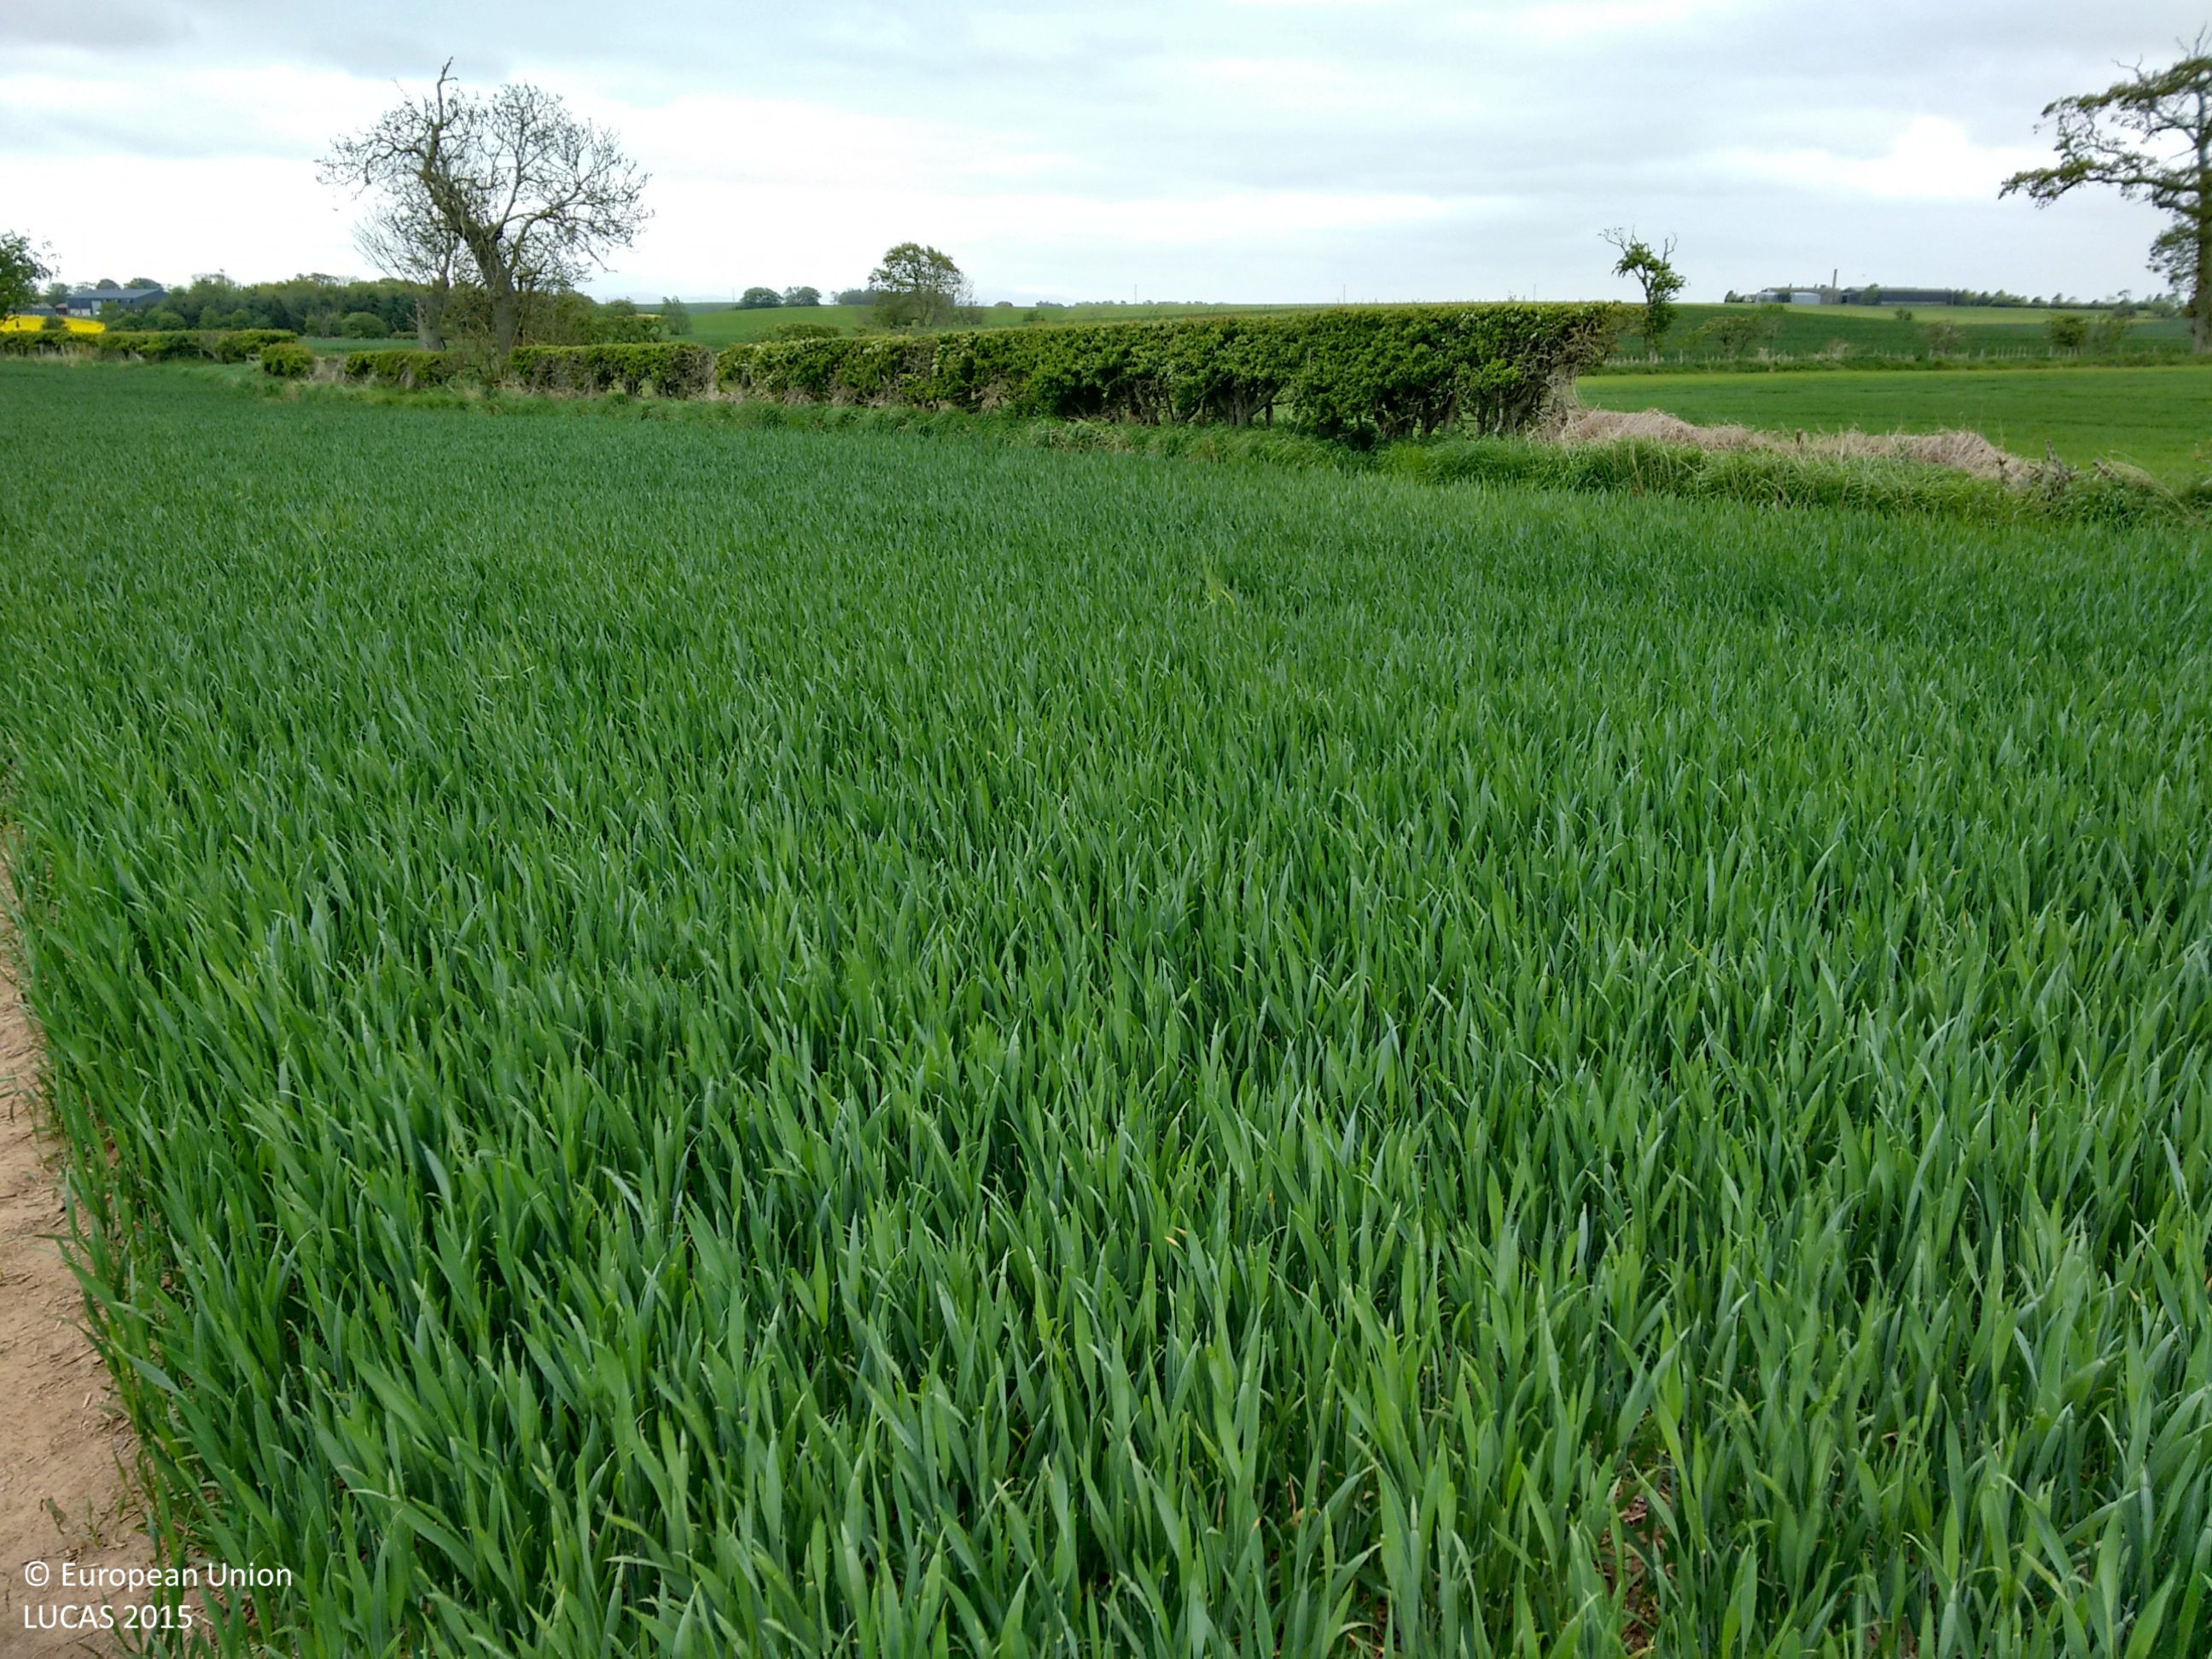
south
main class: Cropland
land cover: Common wheat
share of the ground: > 75 %
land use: Agriculture (excluding fallow land and kitchen gardens)
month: May
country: GB
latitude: 55.7445
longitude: -2.2422
